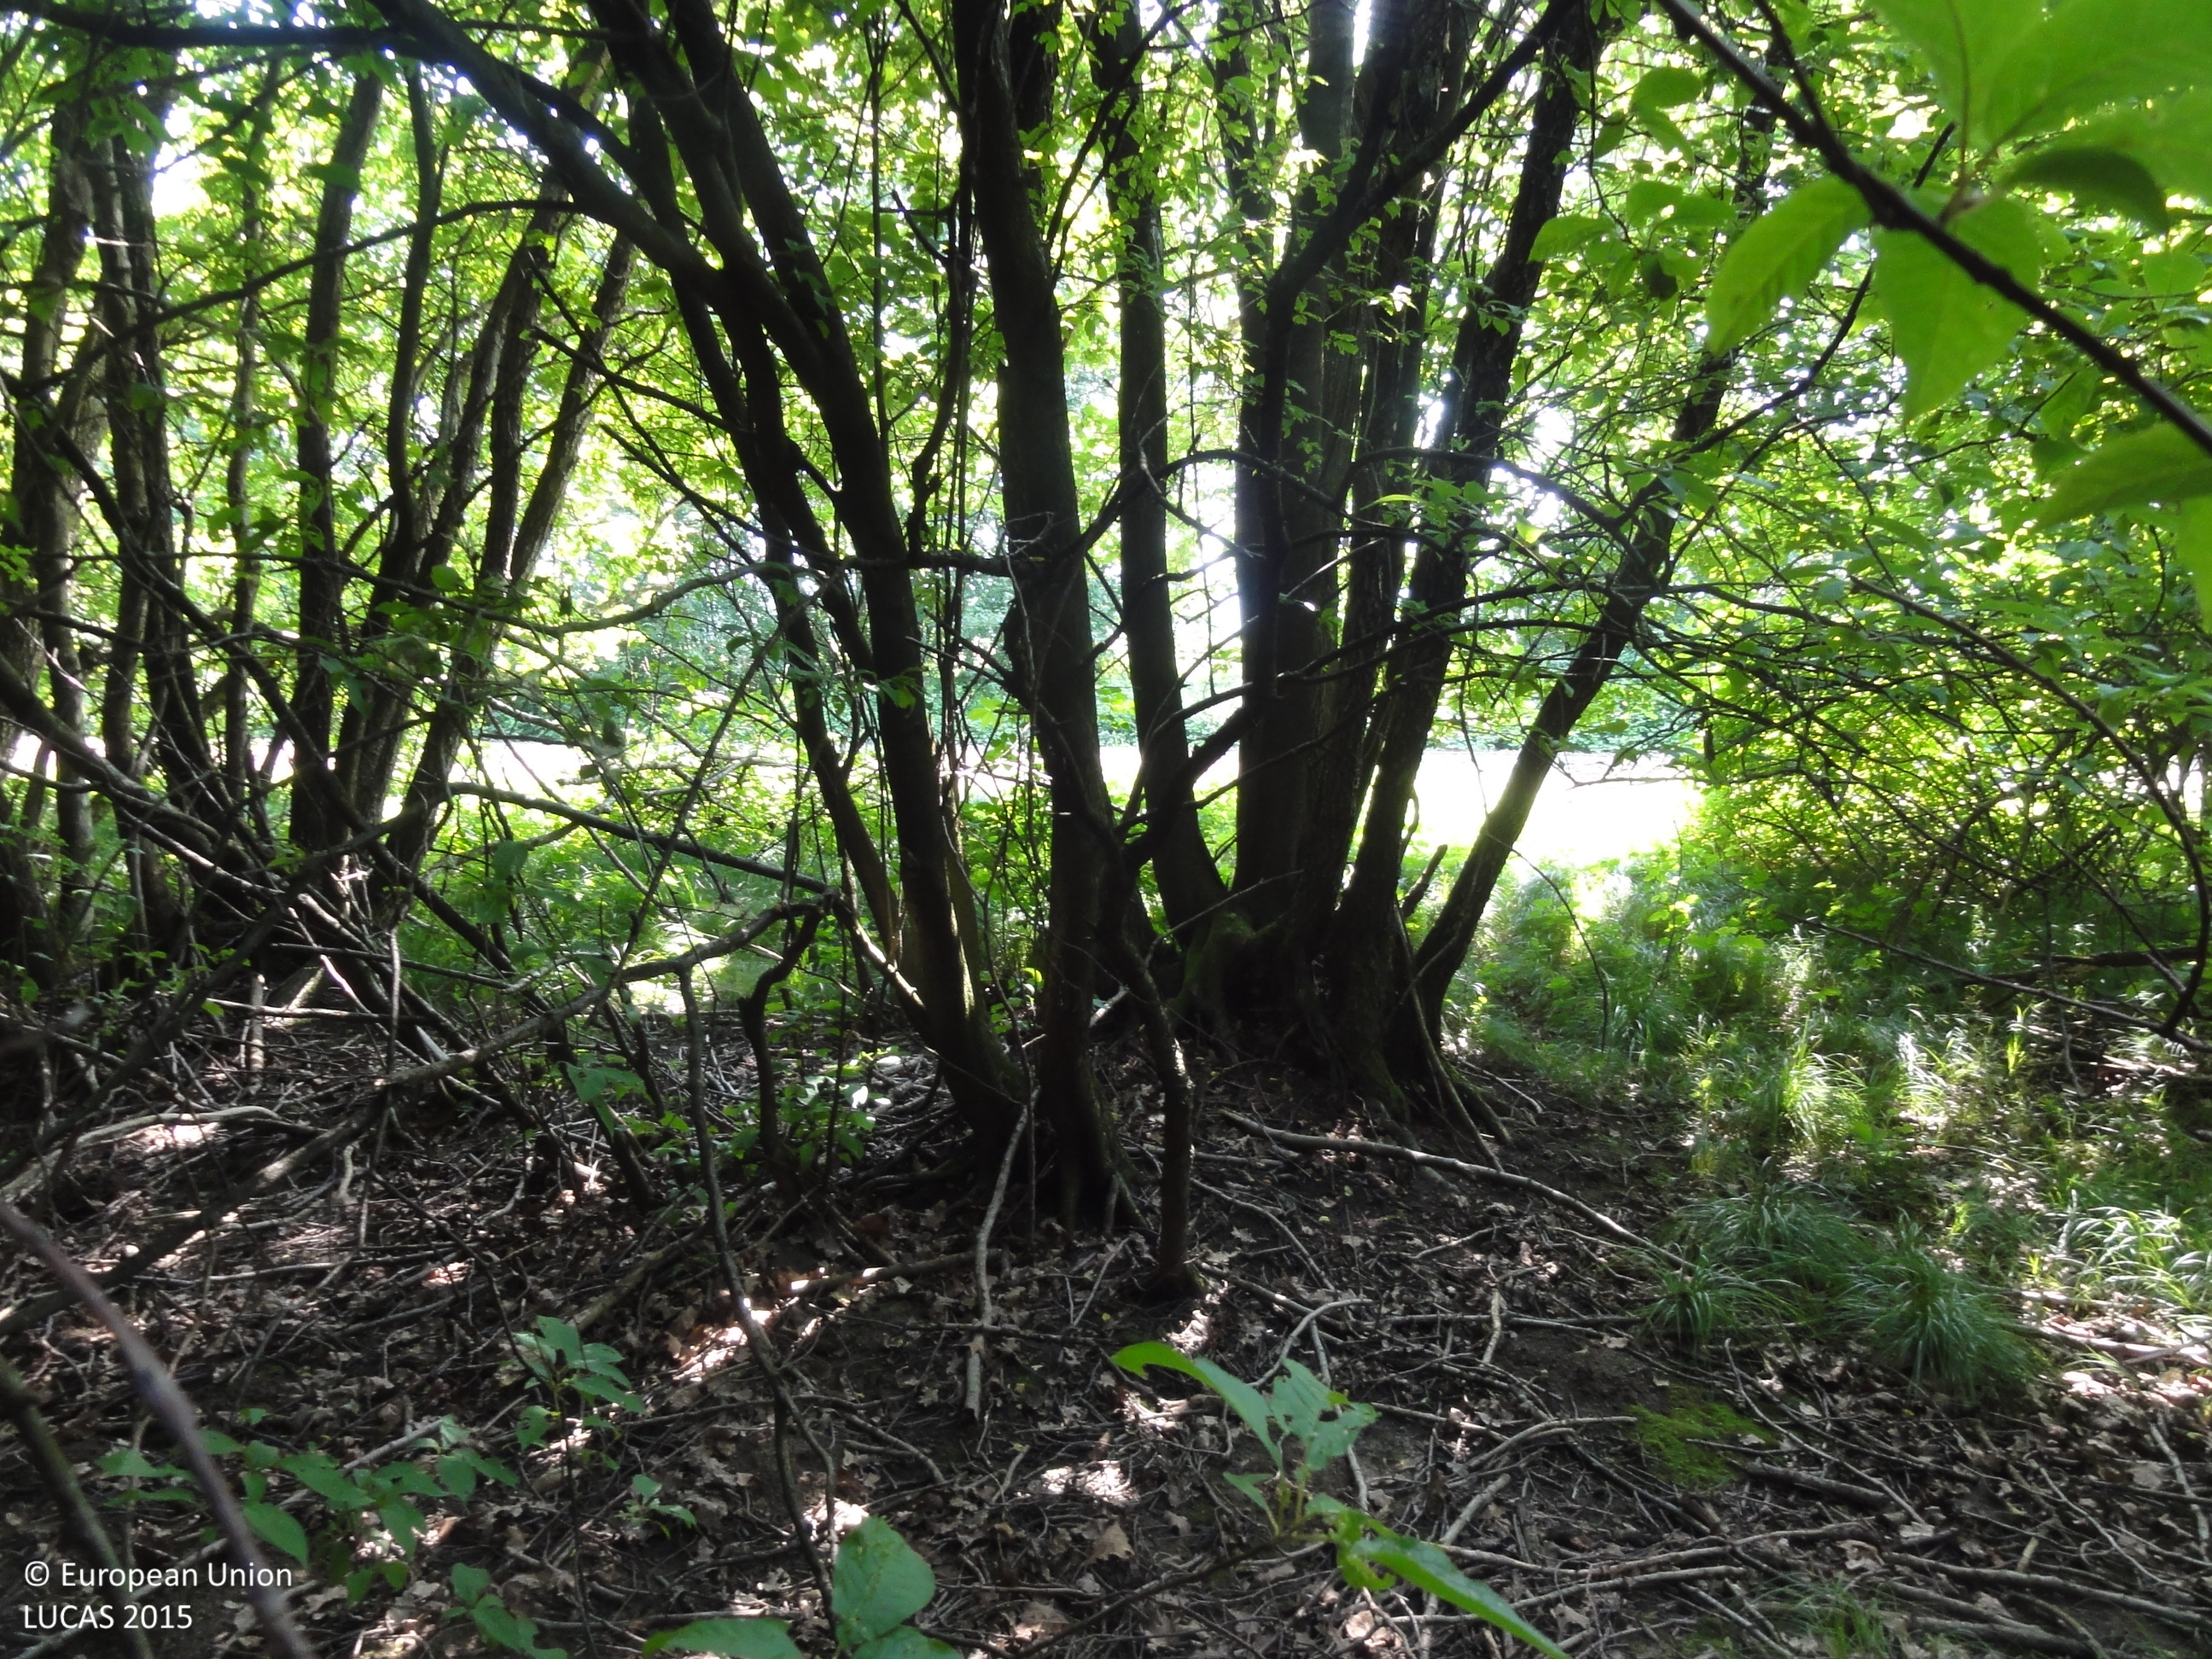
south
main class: Woodland
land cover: Spruce dominated mixed woodland
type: hemiboreal forest and nemoral coniferous forest and mixed broadleaved-coniferous forest
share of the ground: > 75 %
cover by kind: coniferous forest trees 75 %, broadleaved forest trees 25 %
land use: Forestry
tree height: > 5 m
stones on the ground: < 10 %
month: June
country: SI
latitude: 46.3794
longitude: 15.7065
